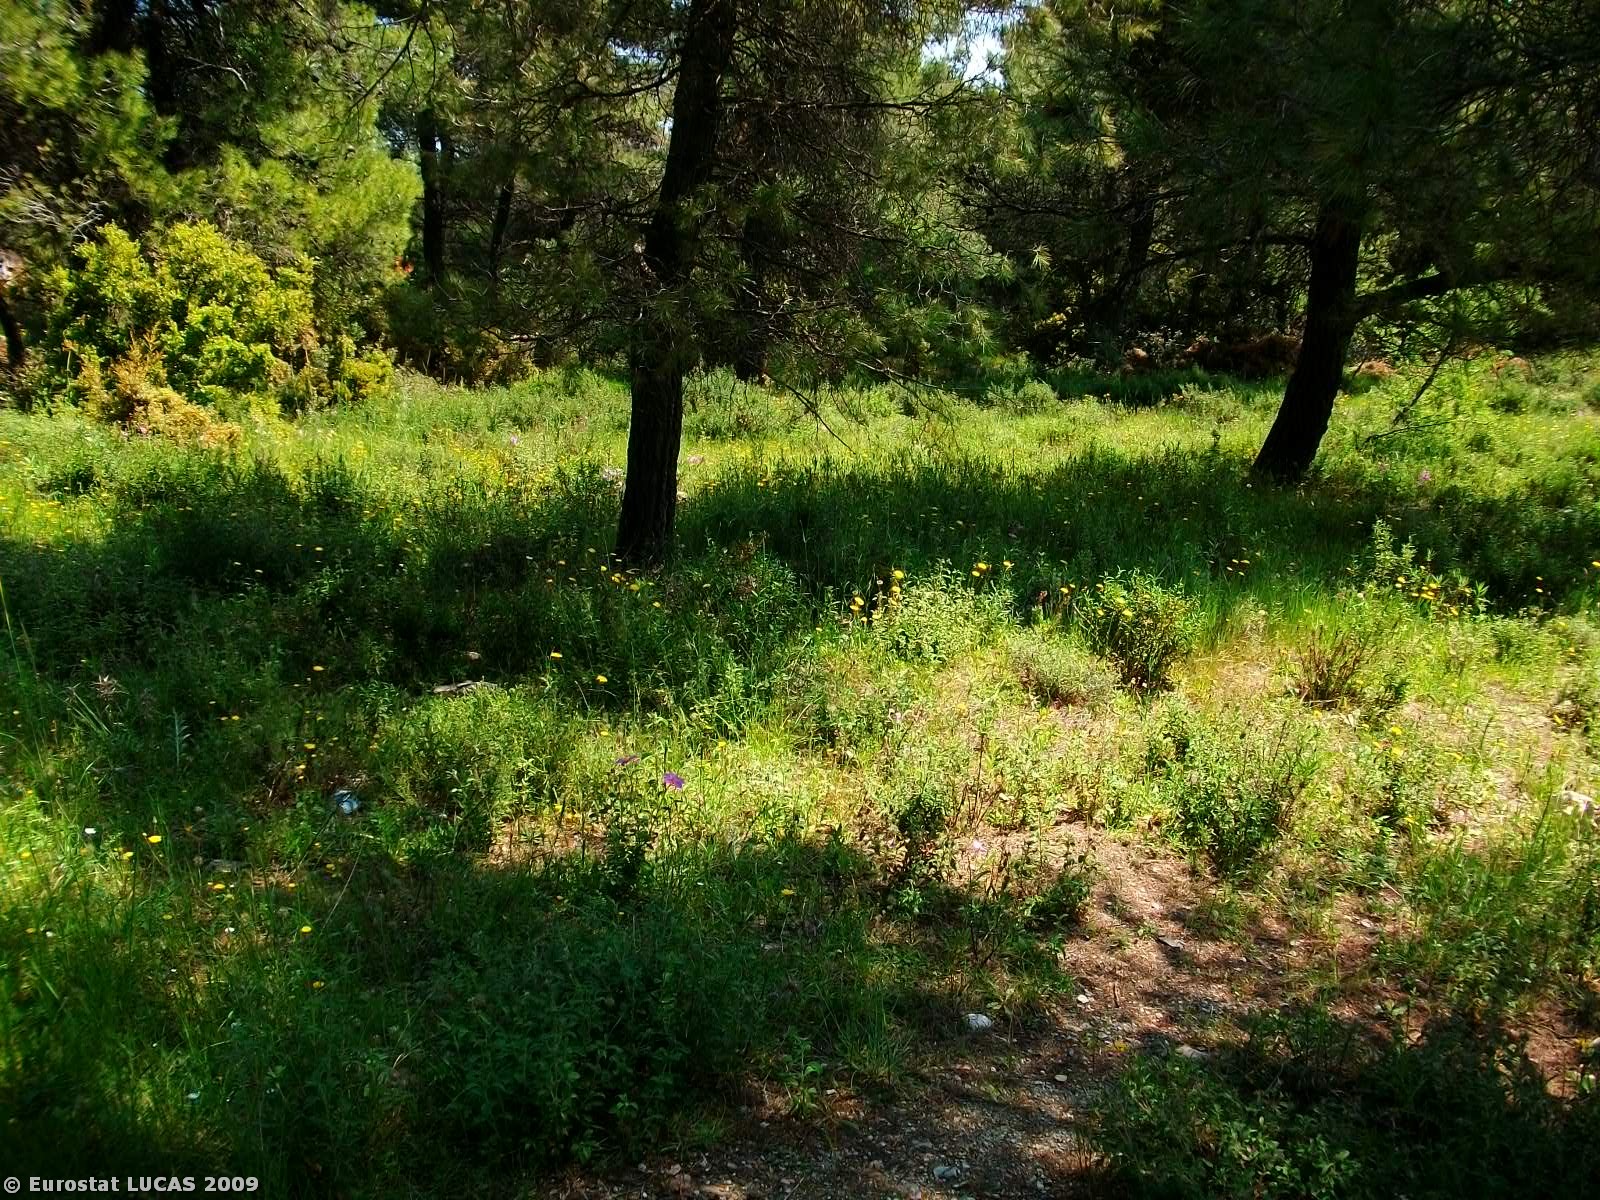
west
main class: Woodland
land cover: Coniferous woodland
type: coniferous forest of the mediterranean region
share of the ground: > 75 %
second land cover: Grassland with sparse tree/shrub cover
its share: 10 - 25 %
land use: Forestry
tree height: > 5 m
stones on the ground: 25 - 50 %
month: May
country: GR
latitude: 38.2030
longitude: 23.8138
